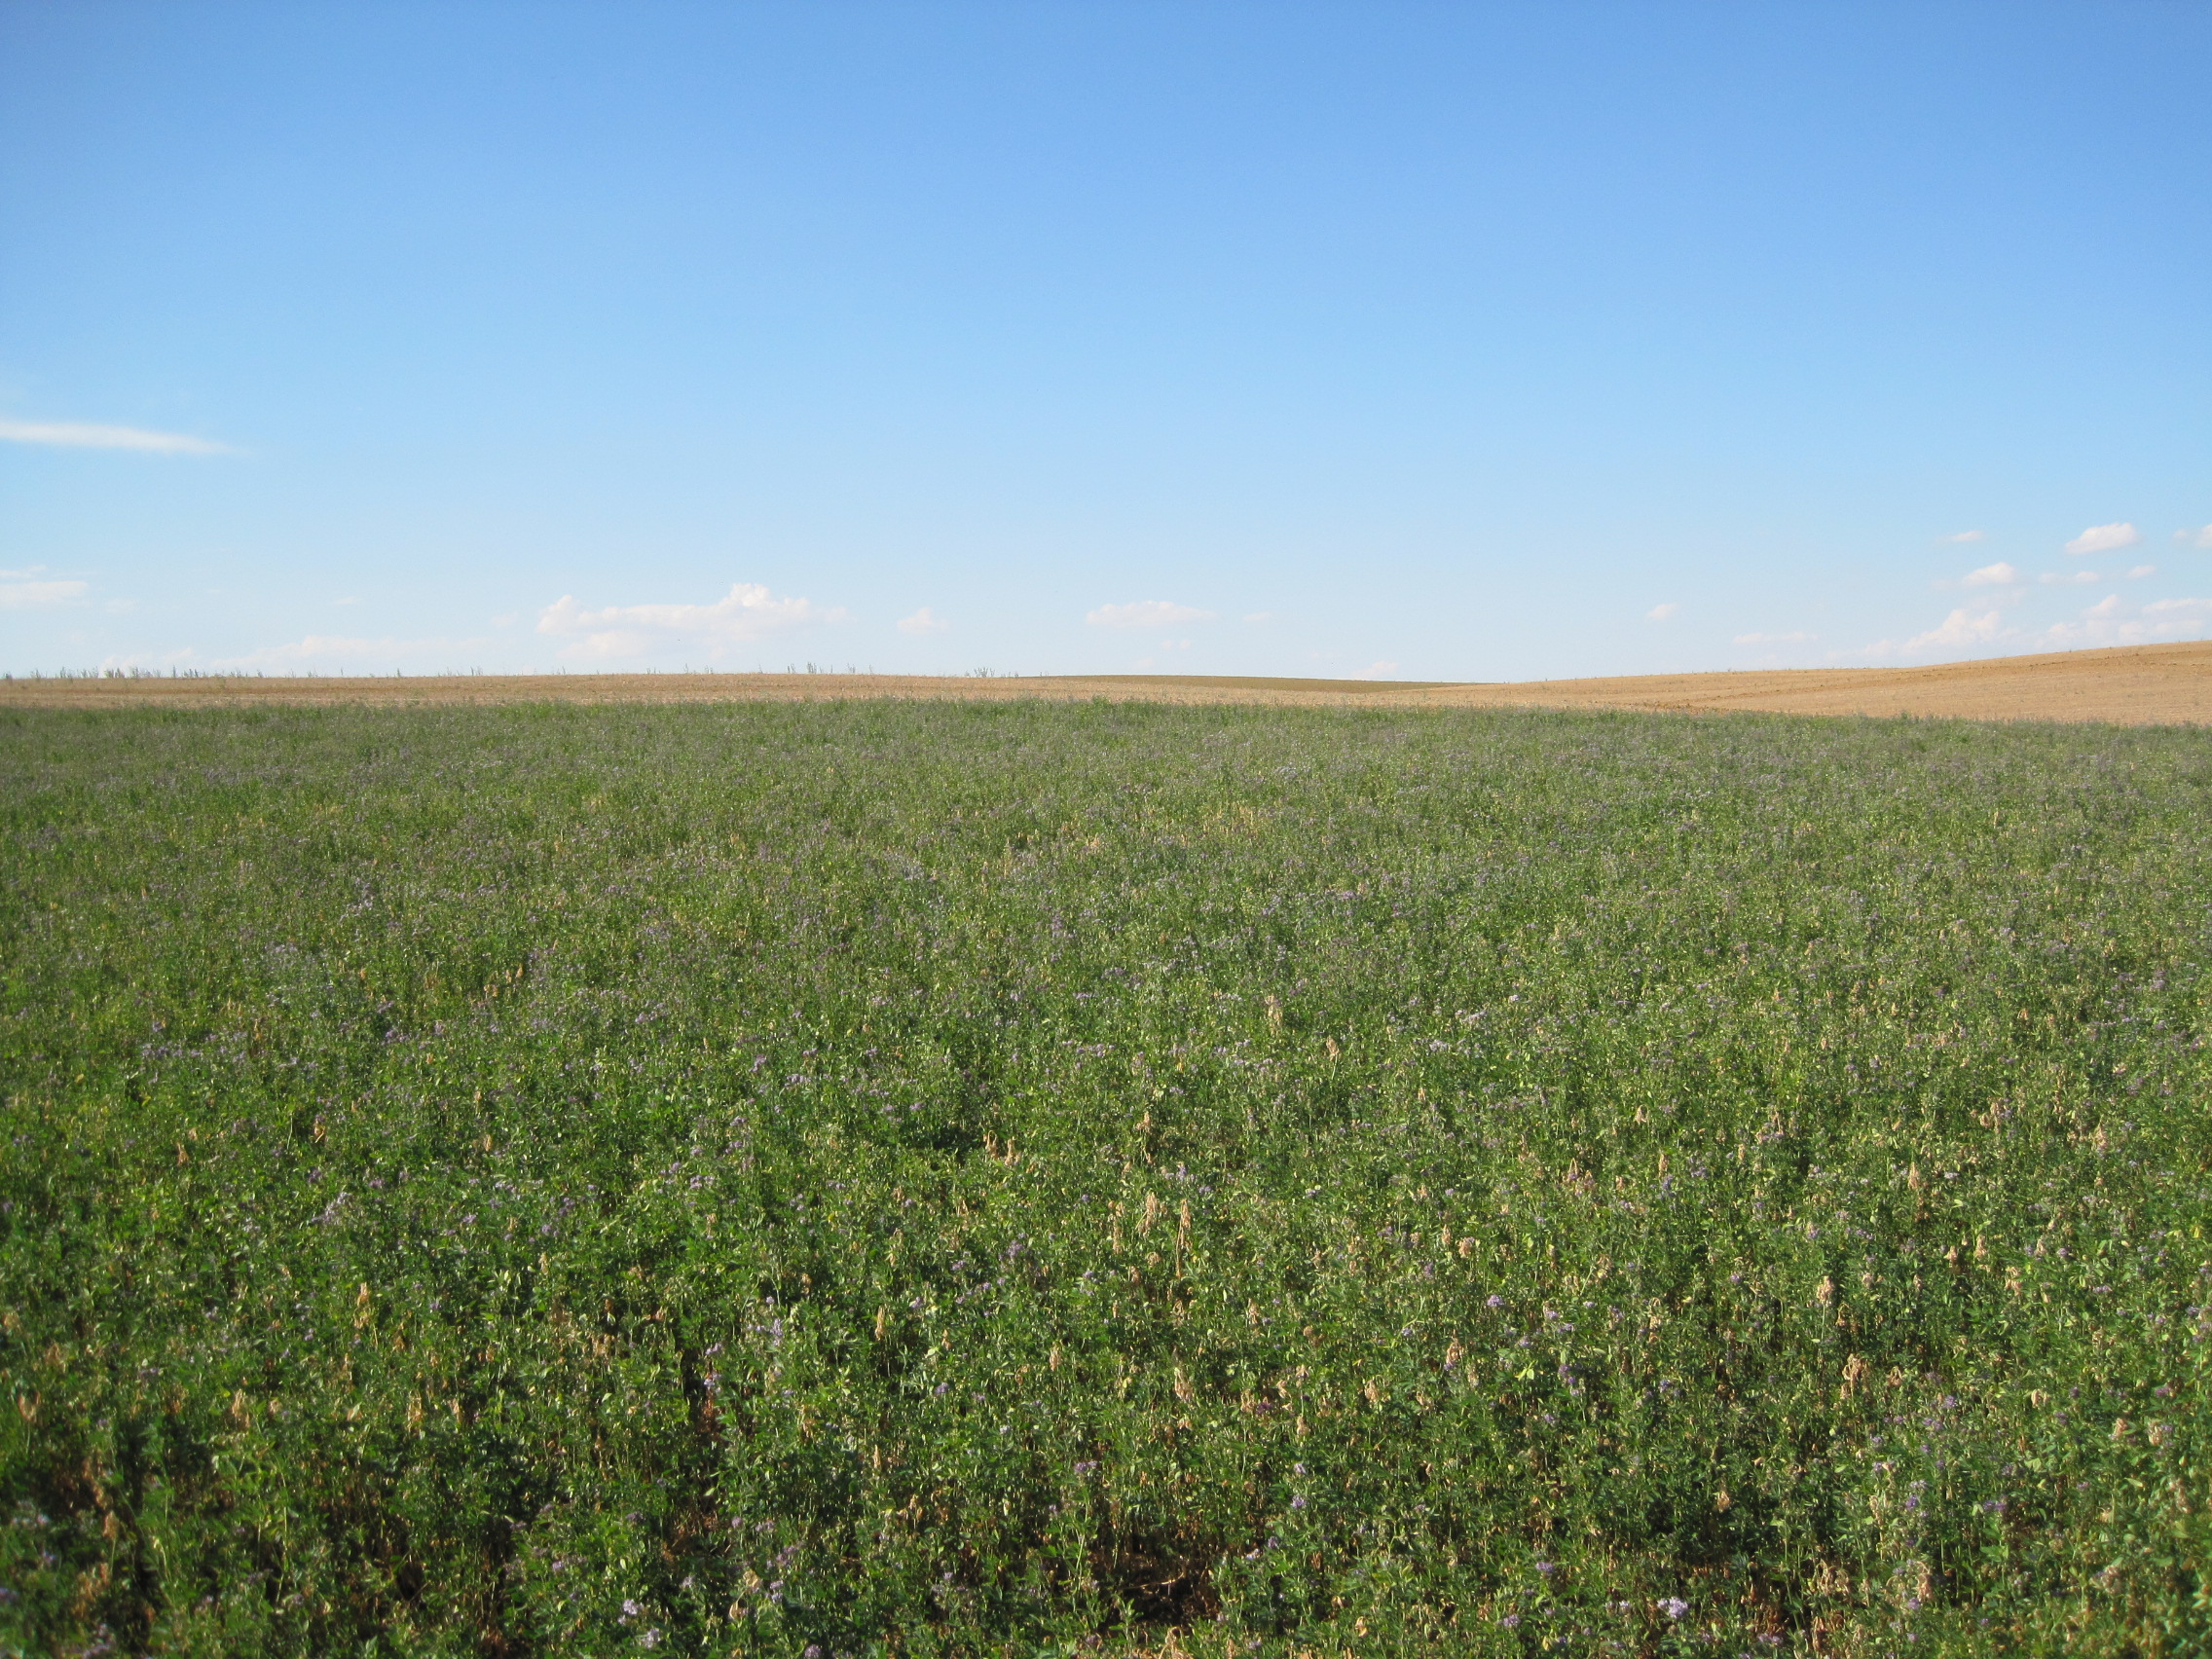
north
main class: Cropland
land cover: Lucerne
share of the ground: > 75 %
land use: Agriculture (excluding fallow land and kitchen gardens)
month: July
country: ES
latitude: 41.9049
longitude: -5.1855
